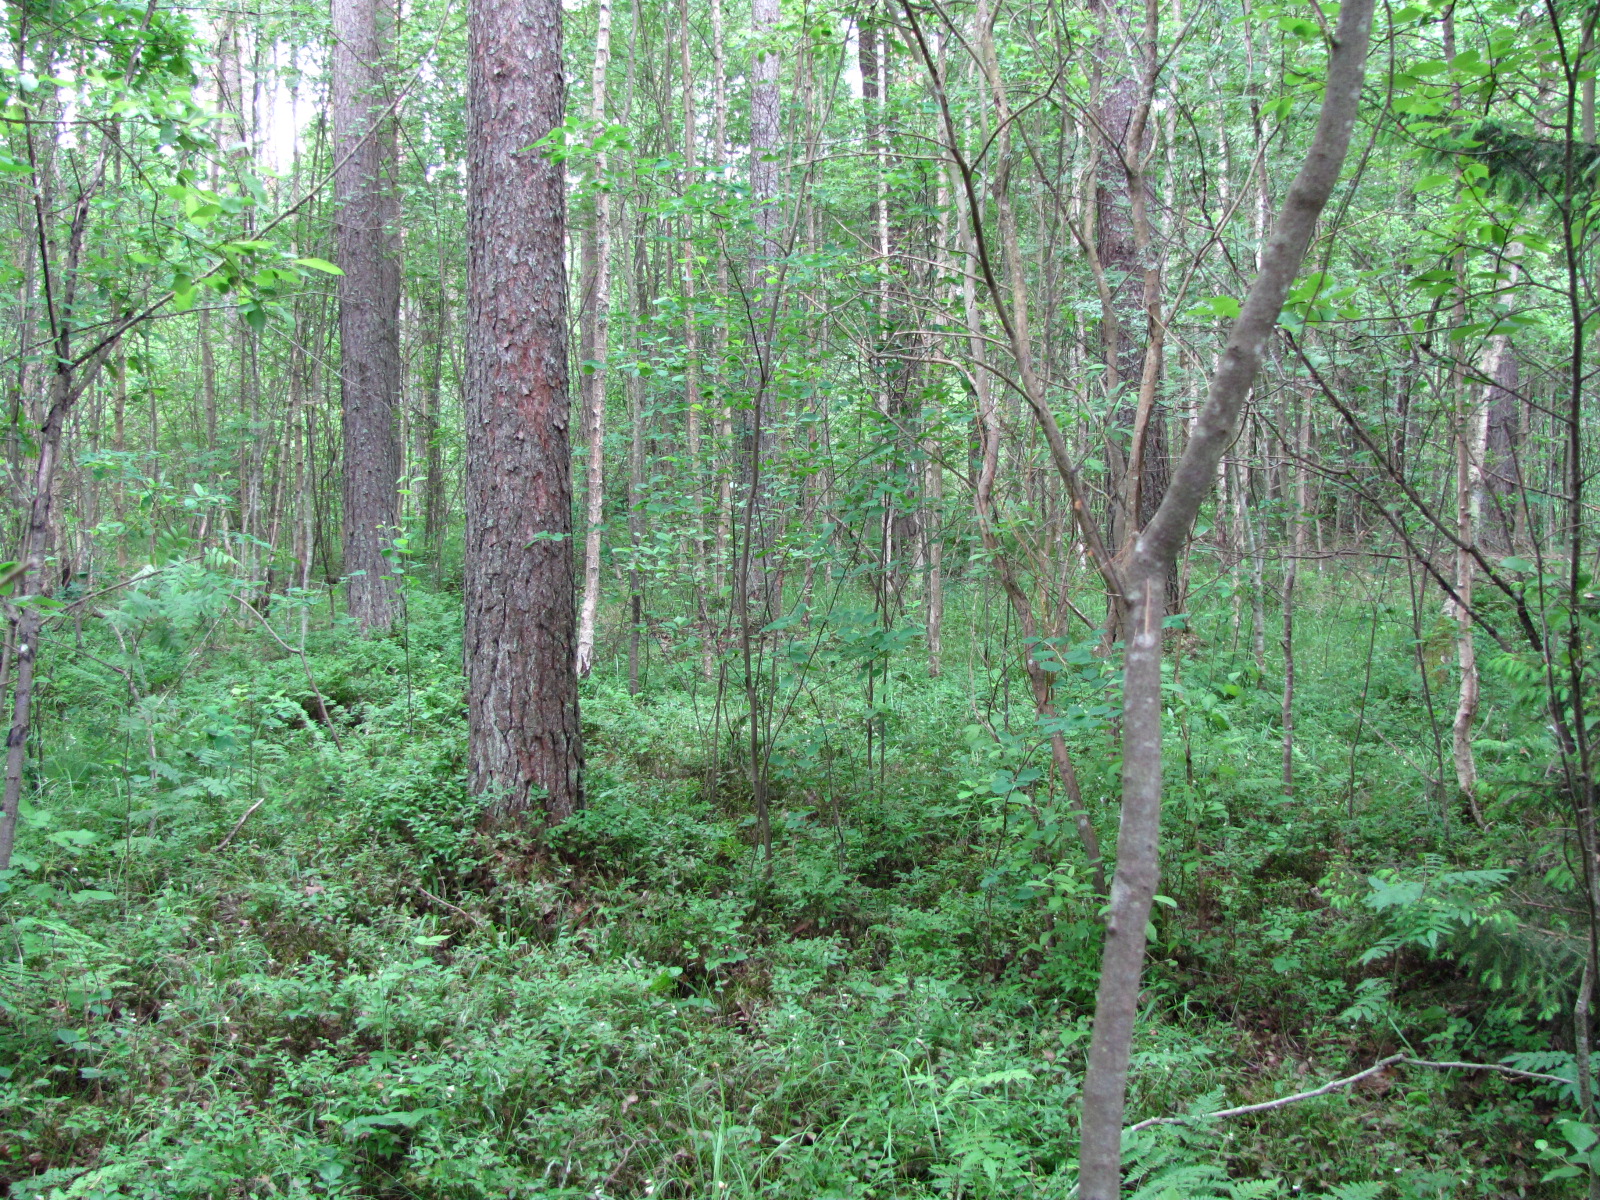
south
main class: Woodland
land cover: Pine dominated mixed woodland
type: hemiboreal forest and nemoral coniferous forest and mixed broadleaved-coniferous forest
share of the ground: > 75 %
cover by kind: coniferous forest trees 50 %, broadleaved forest trees 50 %
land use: Forestry
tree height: > 5 m
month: June
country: LV
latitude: 56.8937
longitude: 23.8532
